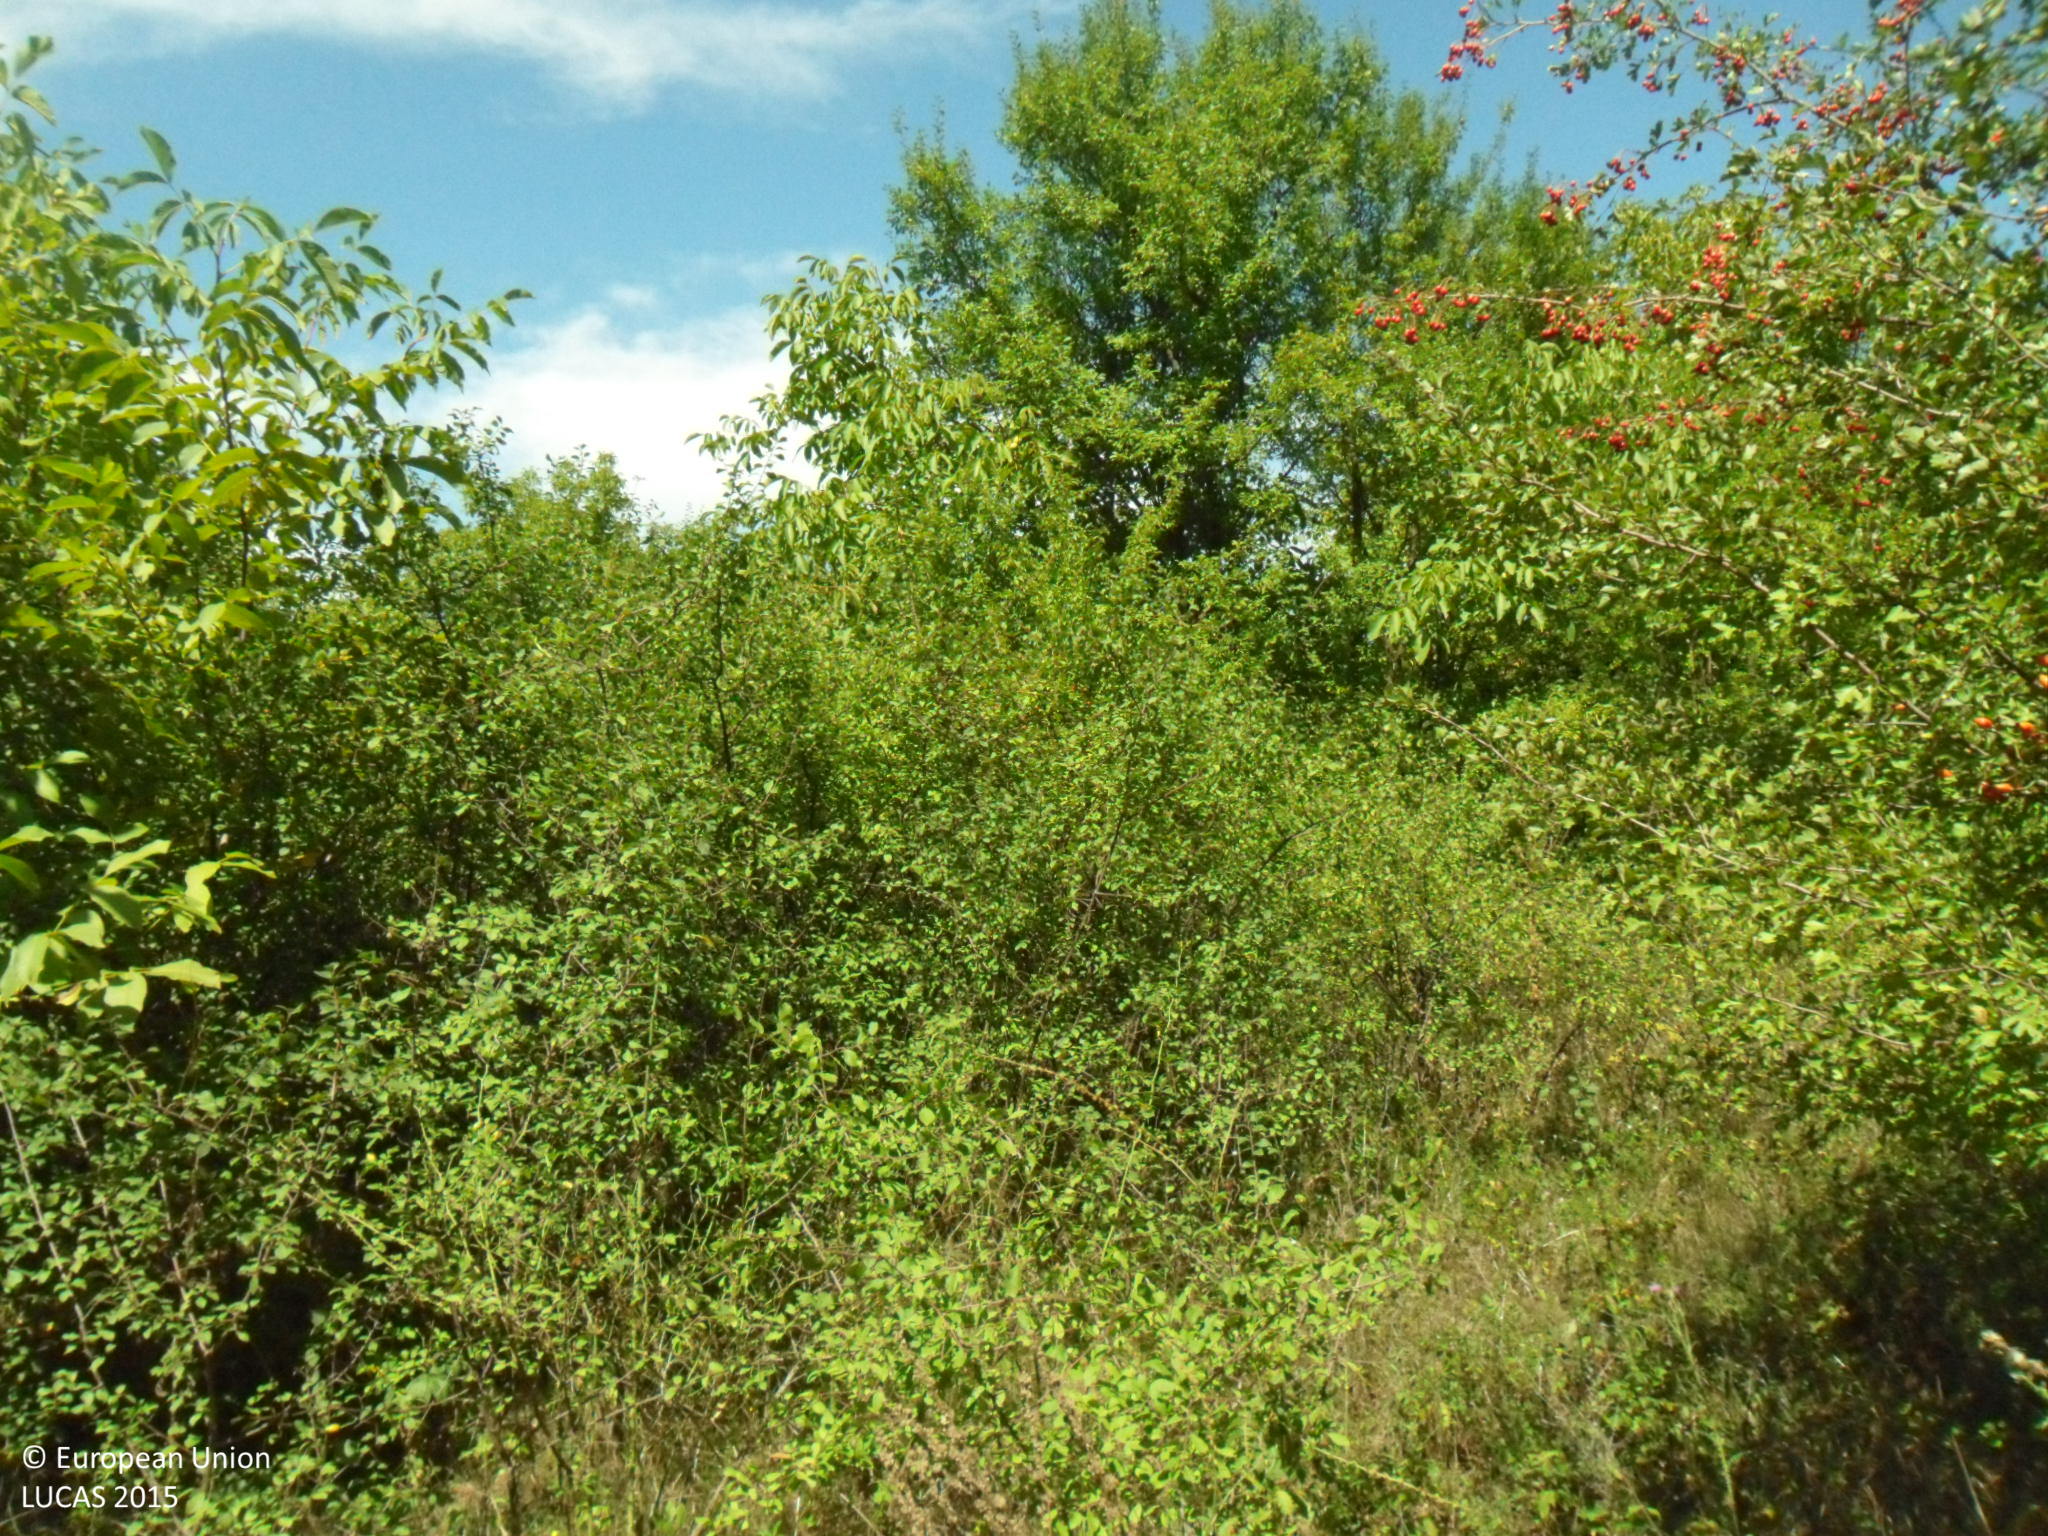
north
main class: Cropland
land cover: Nuts trees
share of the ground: > 75 %
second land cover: Shrubland without tree cover
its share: 50 - 75 %
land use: Agriculture (excluding fallow land and kitchen gardens)
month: September
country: BG
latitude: 43.6346
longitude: 27.2176
